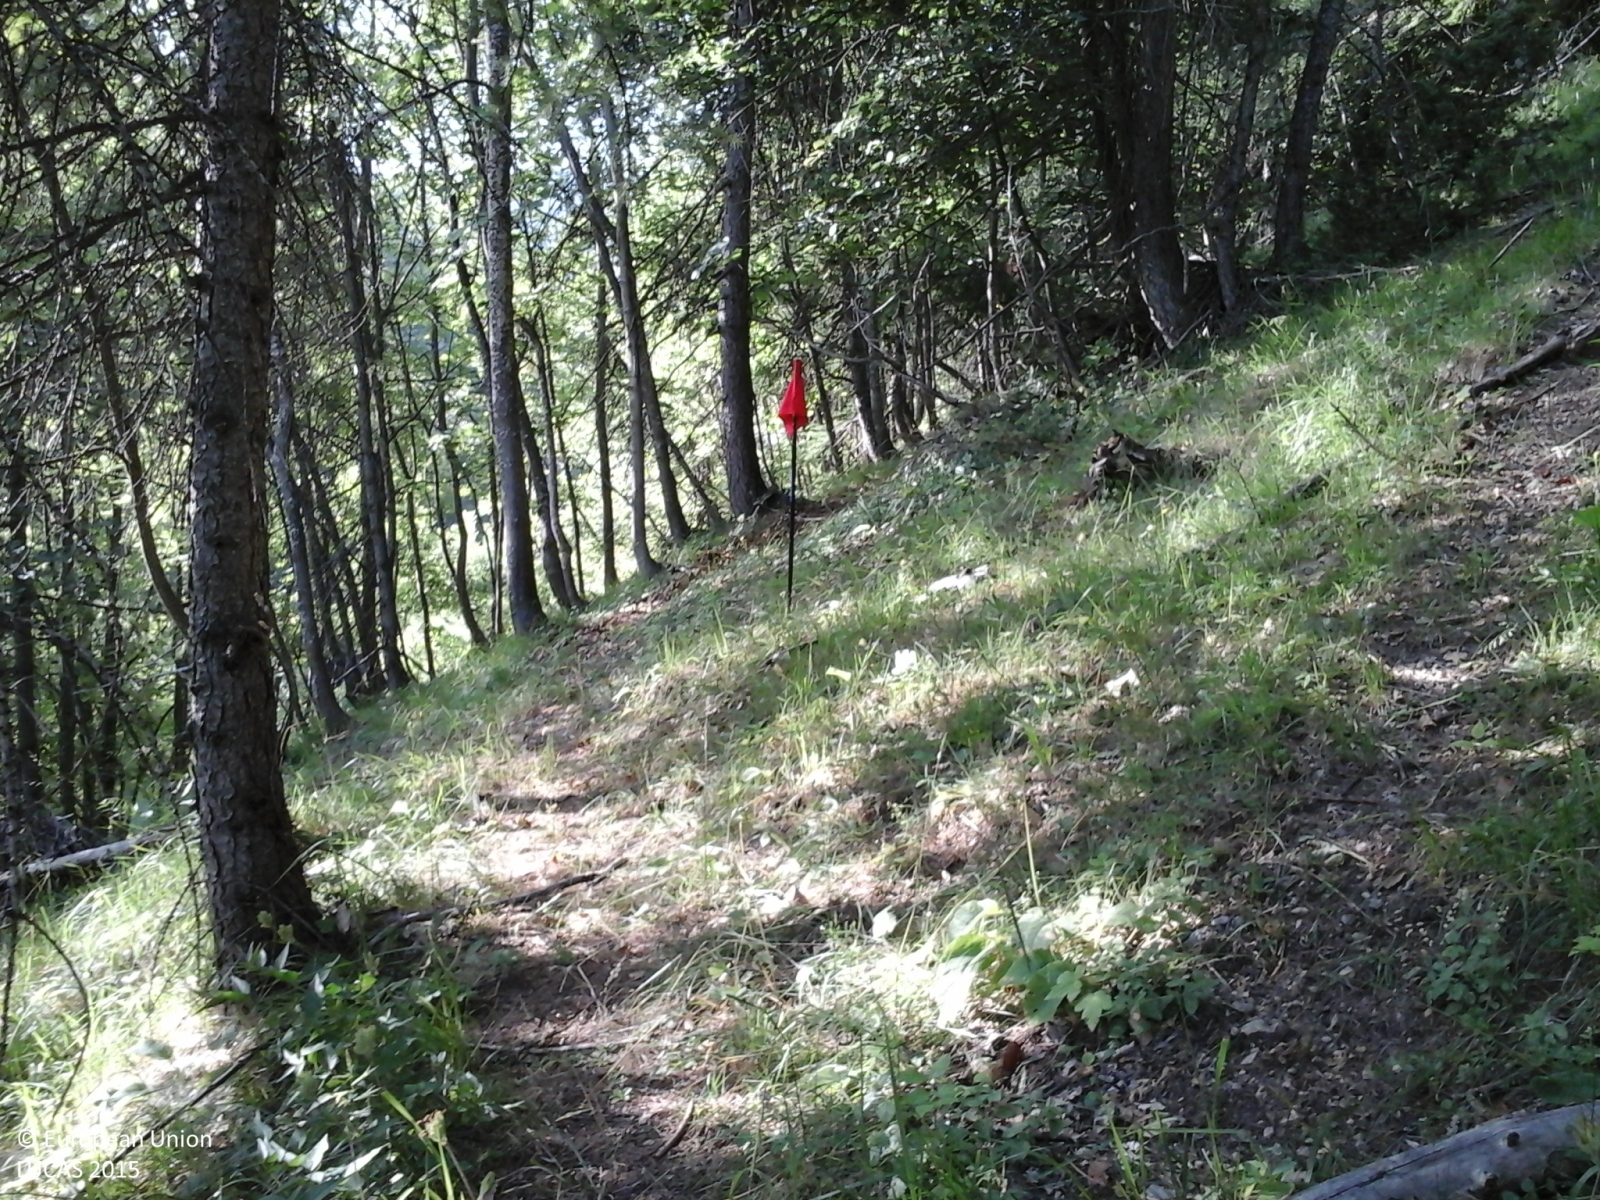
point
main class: Woodland
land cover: Other mixed woodland
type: mesophytic deciduous forest
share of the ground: > 75 %
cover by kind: coniferous forest trees 50 %, broadleaved forest trees 50 %
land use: Forestry
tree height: > 5 m
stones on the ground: < 10 %
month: July
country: IT
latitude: 44.2964
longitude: 7.2609
